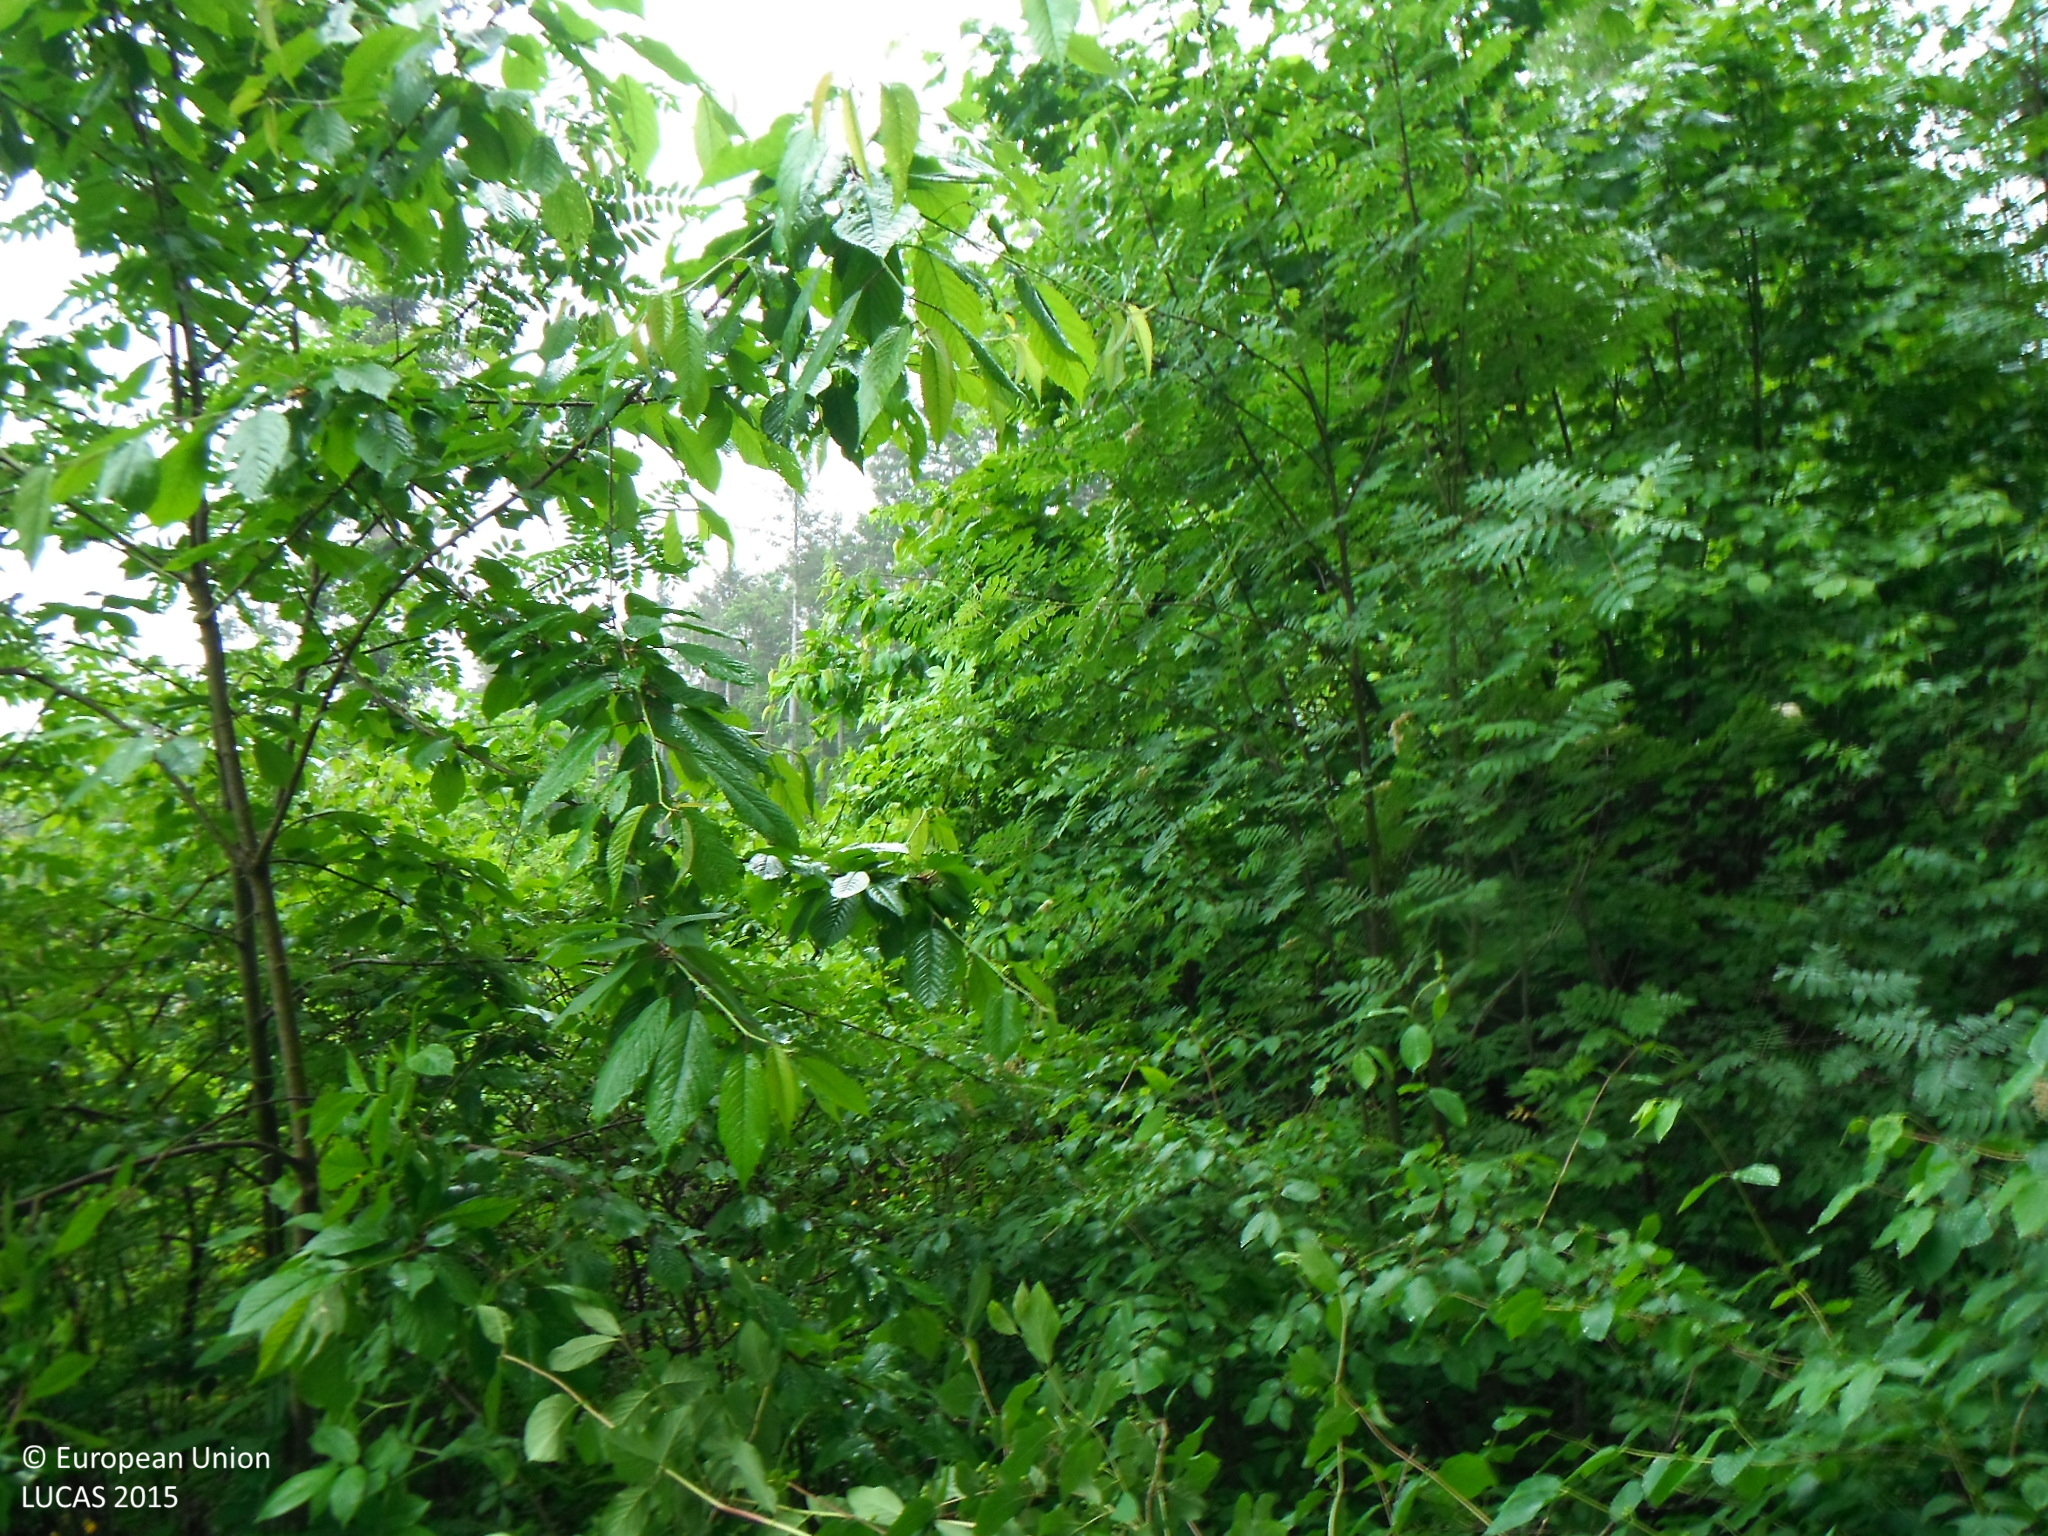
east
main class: Woodland
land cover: Other coniferous woodland
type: hemiboreal forest and nemoral coniferous forest and mixed broadleaved-coniferous forest
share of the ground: > 75 %
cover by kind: coniferous forest trees 85 %, shrubs 15 %
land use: Forestry
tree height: > 5 m
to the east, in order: Other coniferous woodland; Shrubland without tree cover; Ditches and canals; Grass margins; Paved roads, cycling and walking lanes; Spontaneously vegetated surfaces; Other coniferous woodland; Broadleaved woodland; Rivers and streams; Broadleaved woodland; Shrubland without tree cover; Paved roads, cycling and walking lanes; Grass margins; Broadleaved woodland
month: May
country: SK
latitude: 48.9993
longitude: 21.1565
